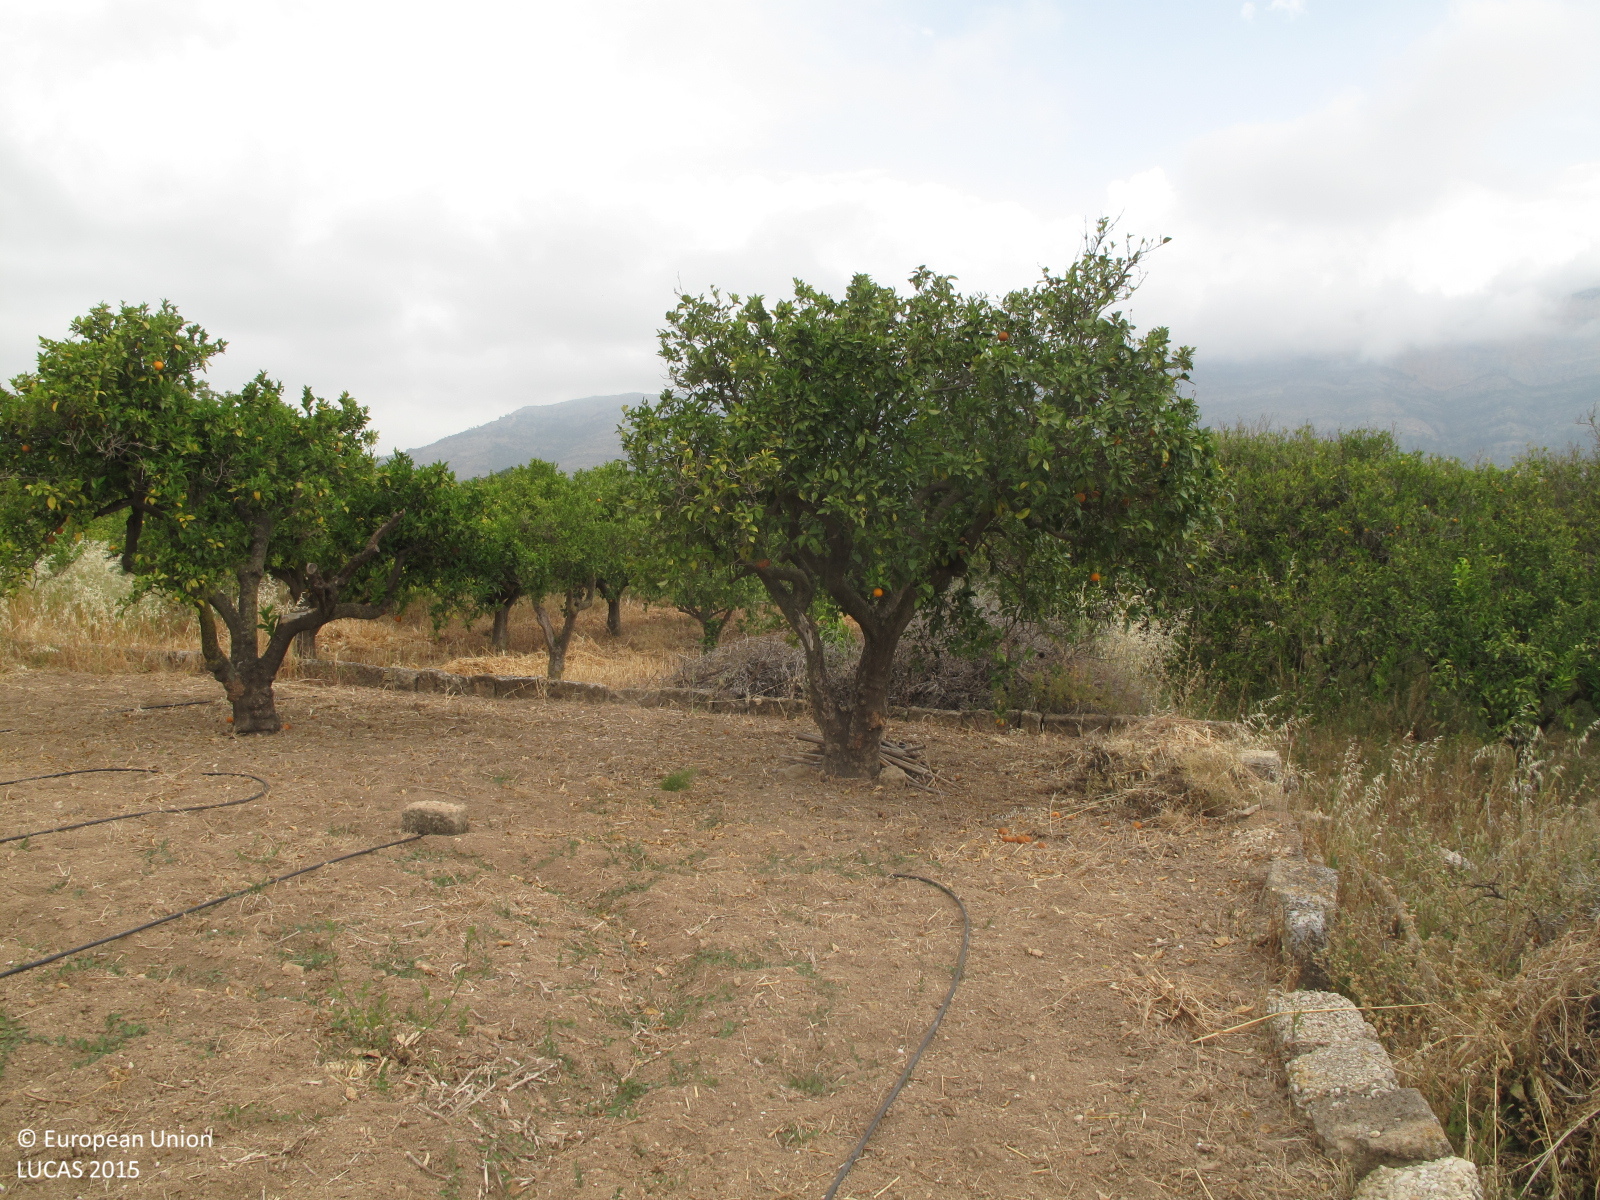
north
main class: Cropland
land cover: Oranges
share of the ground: < 10 %
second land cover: Other bare soil
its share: > 75 %
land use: Agriculture (excluding fallow land and kitchen gardens)
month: May
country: ES
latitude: 38.7811
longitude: 0.1005
